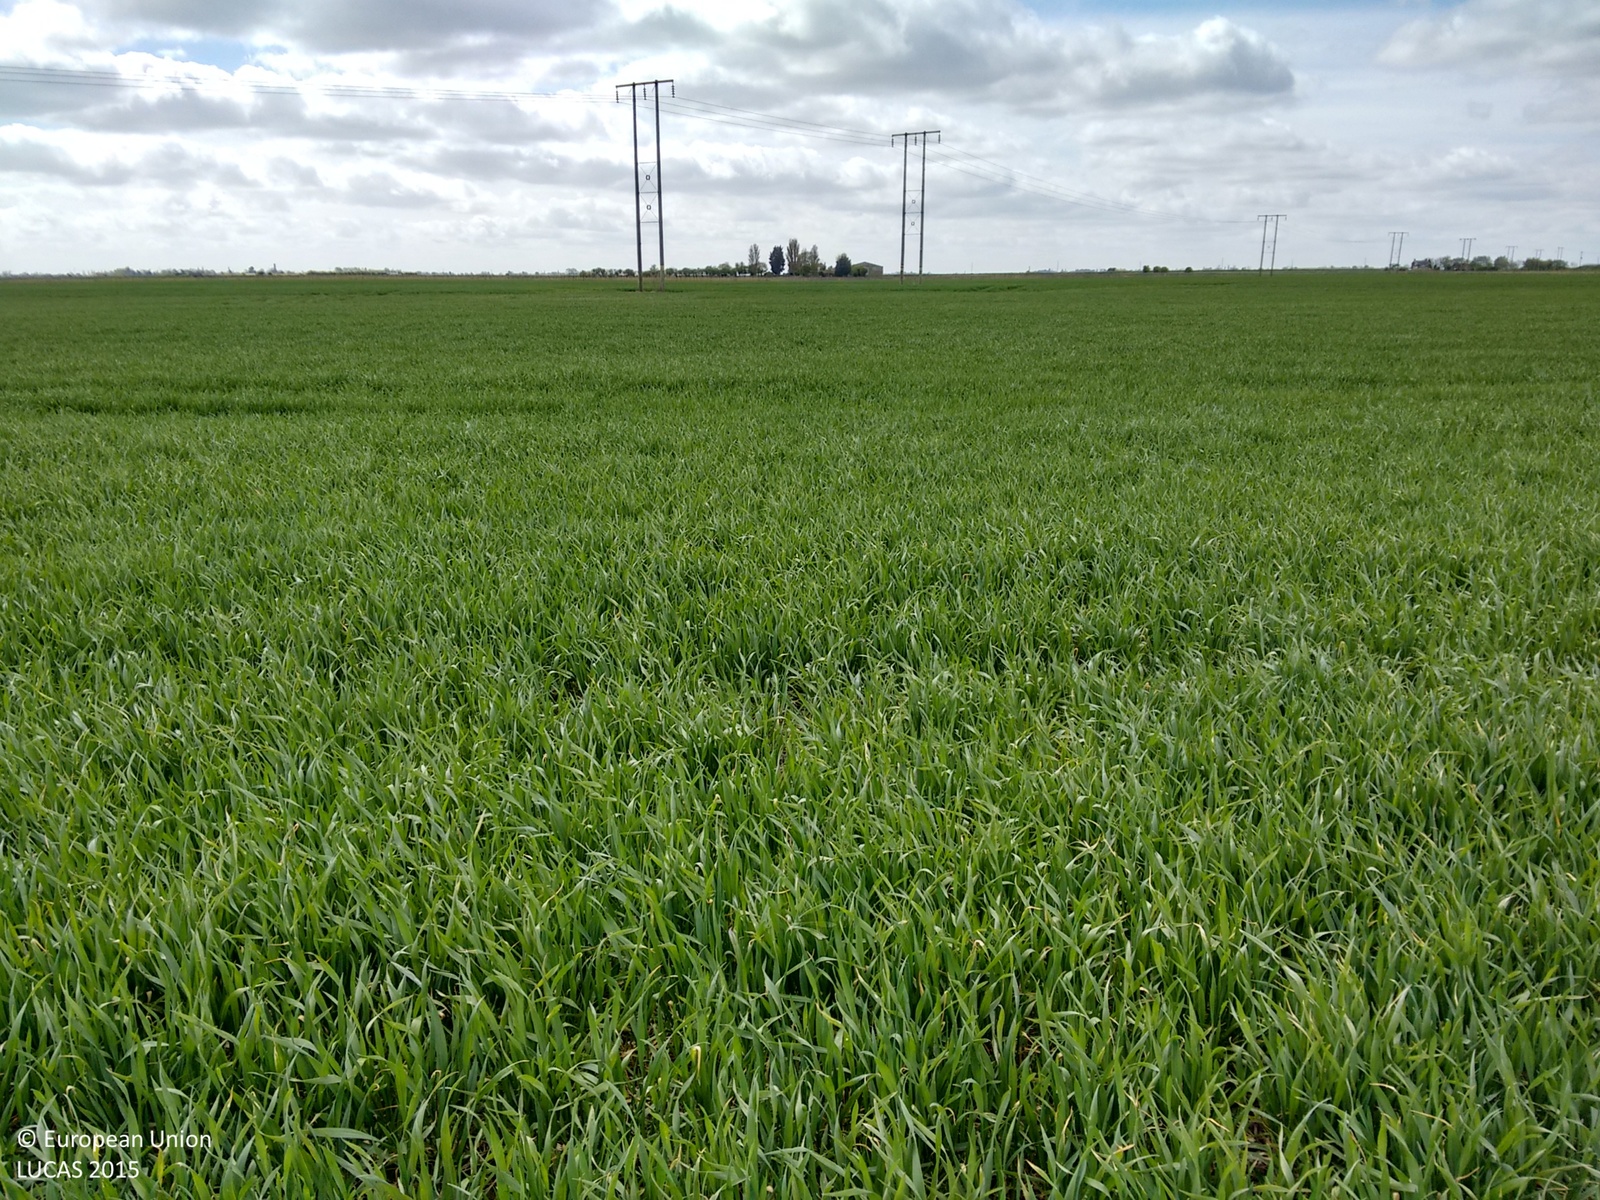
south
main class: Cropland
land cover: Common wheat
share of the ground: > 75 %
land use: Agriculture (excluding fallow land and kitchen gardens)
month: May
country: GB
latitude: 53.0988
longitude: 0.0367
